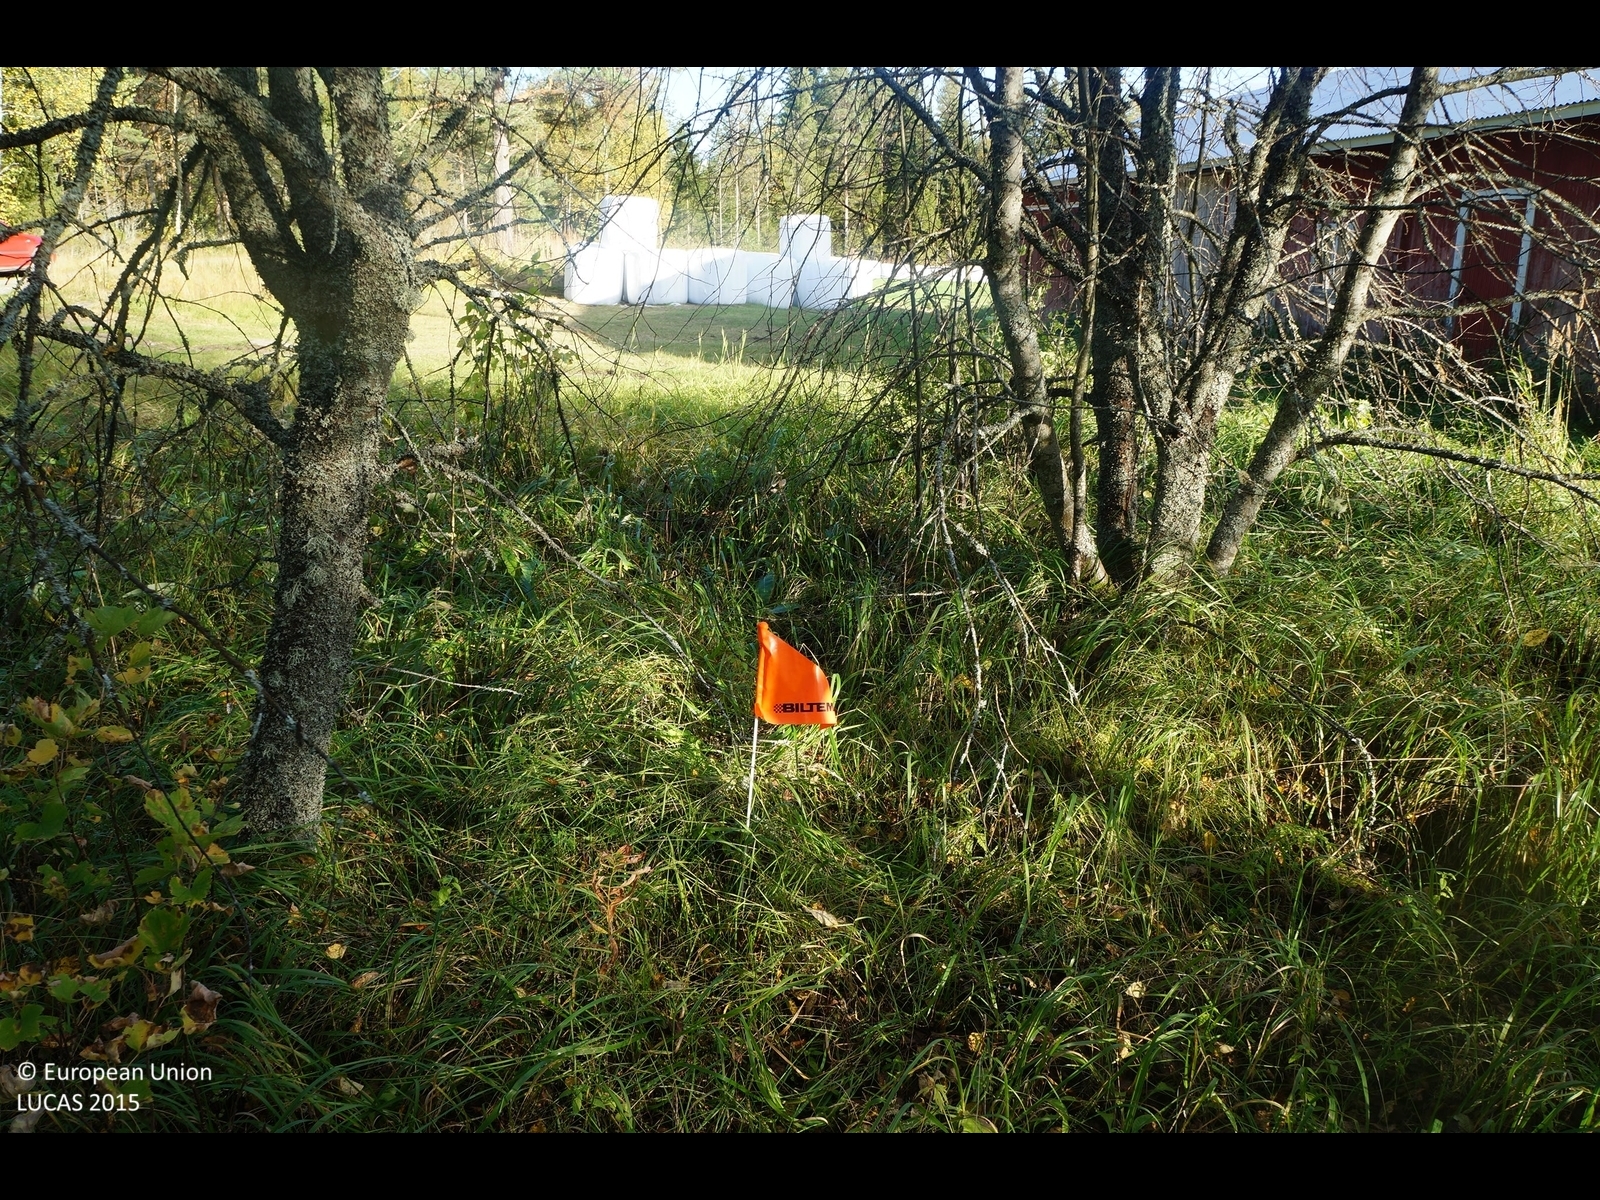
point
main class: Woodland
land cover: Broadleaved woodland
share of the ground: 25 - 50 %
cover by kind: herbaceous plants 65 %, broadleaved forest trees 30 %, coniferous forest trees 5 %
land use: Residential
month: September
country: FI
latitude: 64.2555
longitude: 24.3690
